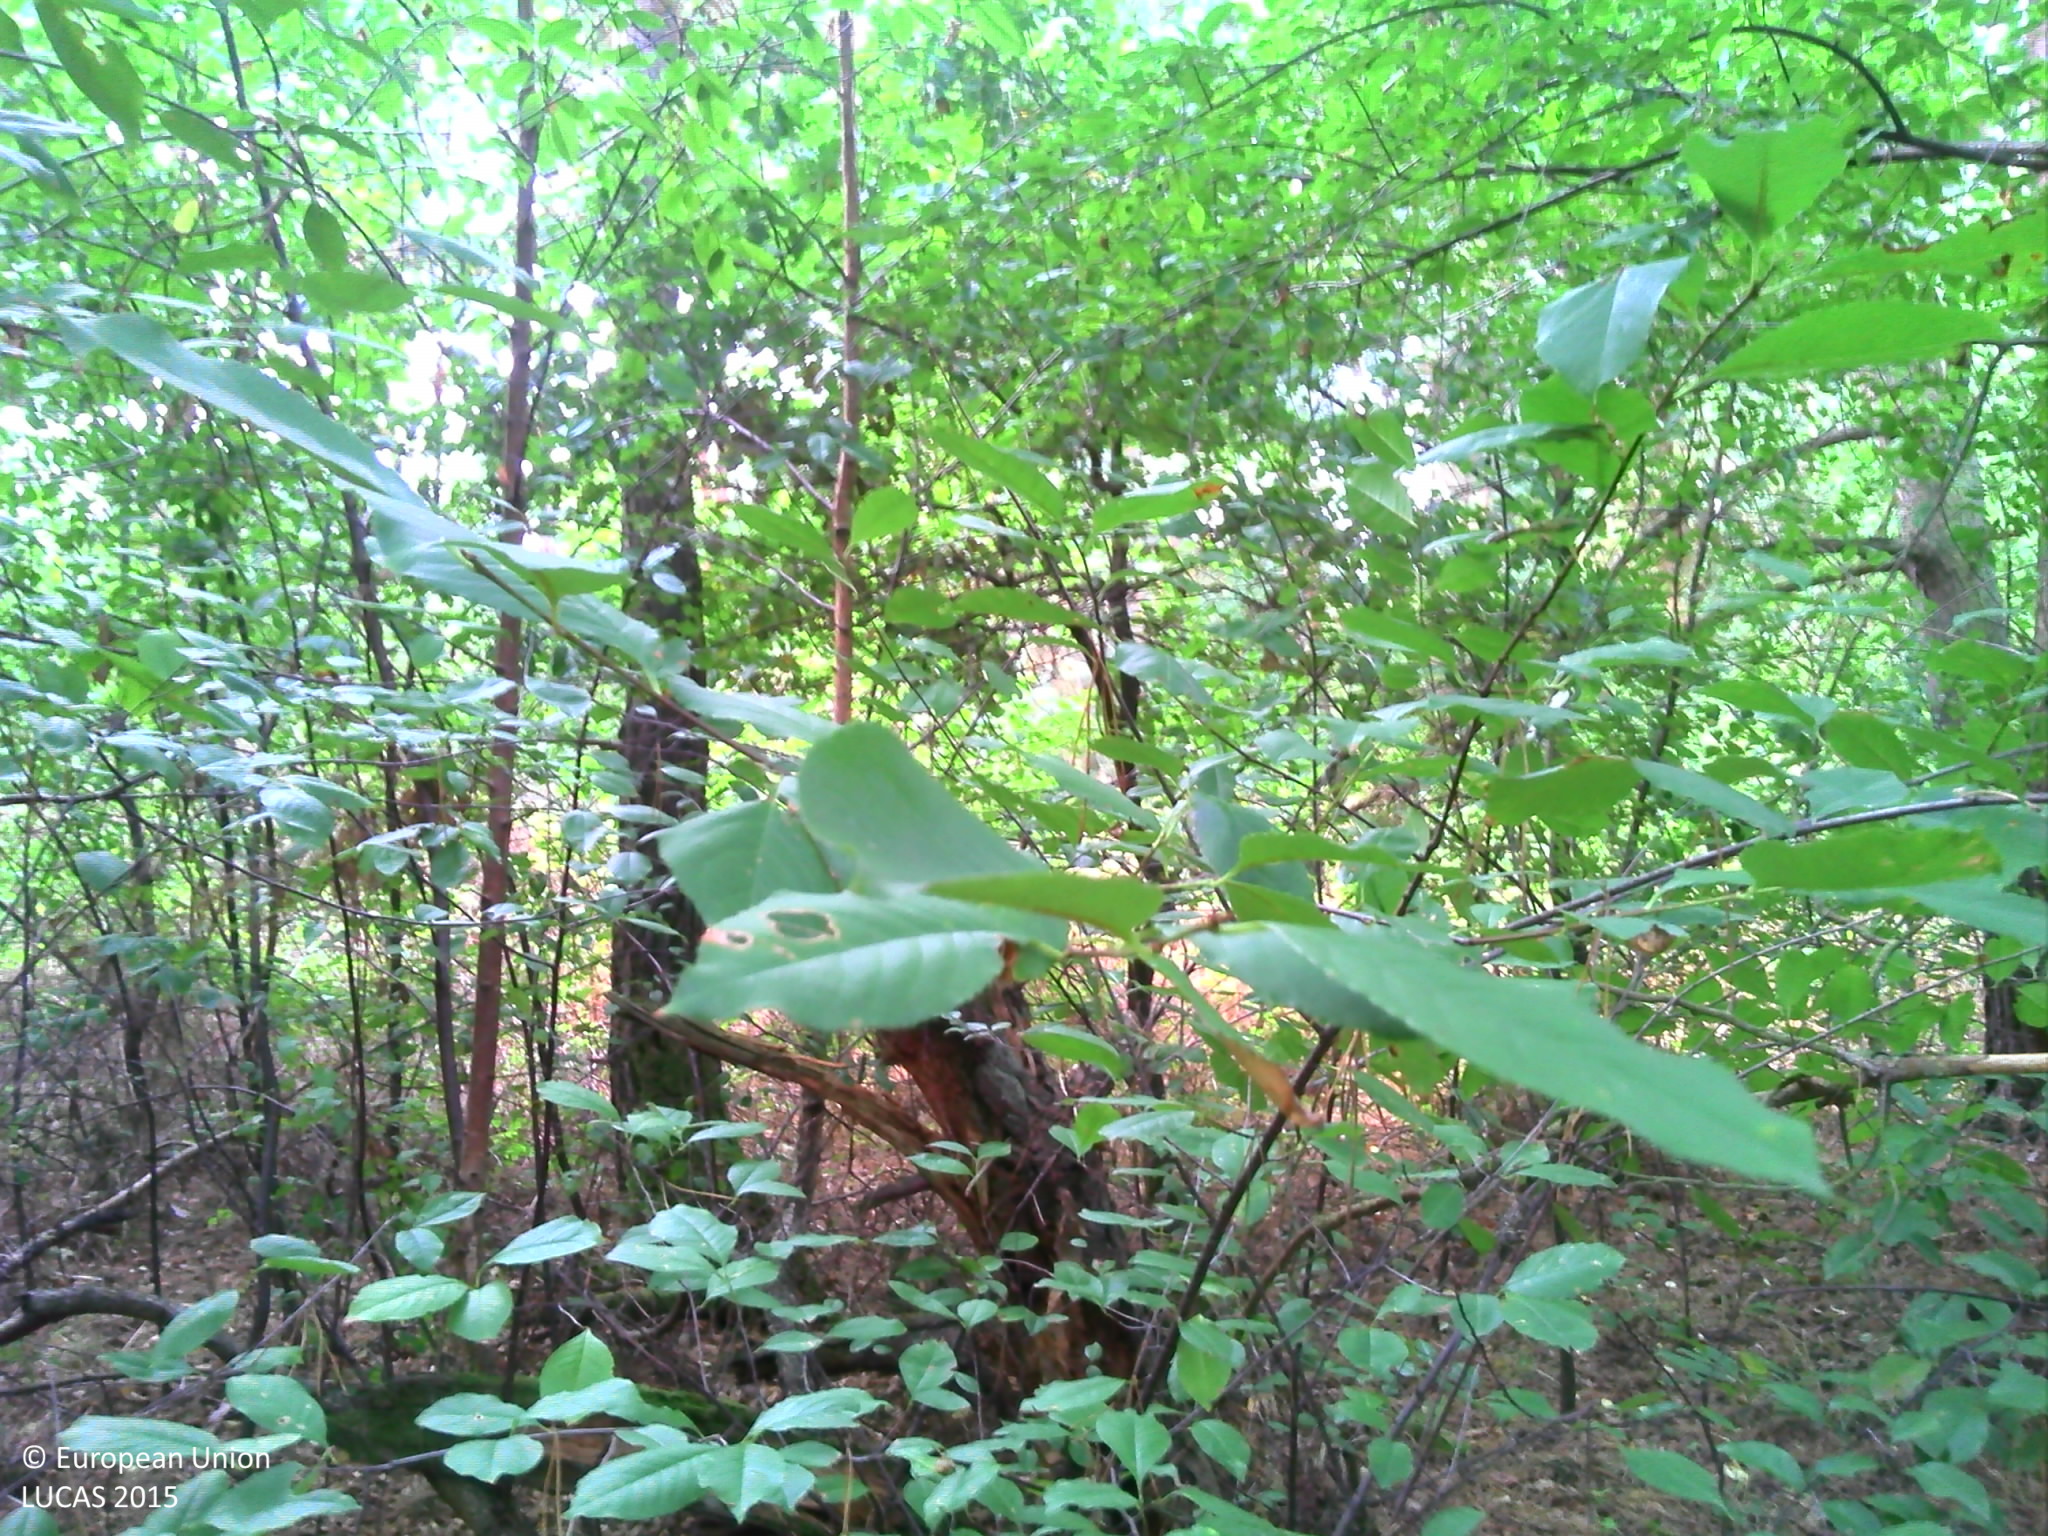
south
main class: Woodland
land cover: Pine dominated mixed woodland
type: hemiboreal forest and nemoral coniferous forest and mixed broadleaved-coniferous forest
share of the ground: > 75 %
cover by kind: broadleaved forest trees 50 %, coniferous forest trees 35 %, herbaceous plants 15 %
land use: Forestry
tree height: > 5 m
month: August
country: FR
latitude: 48.7042
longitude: 7.7315
